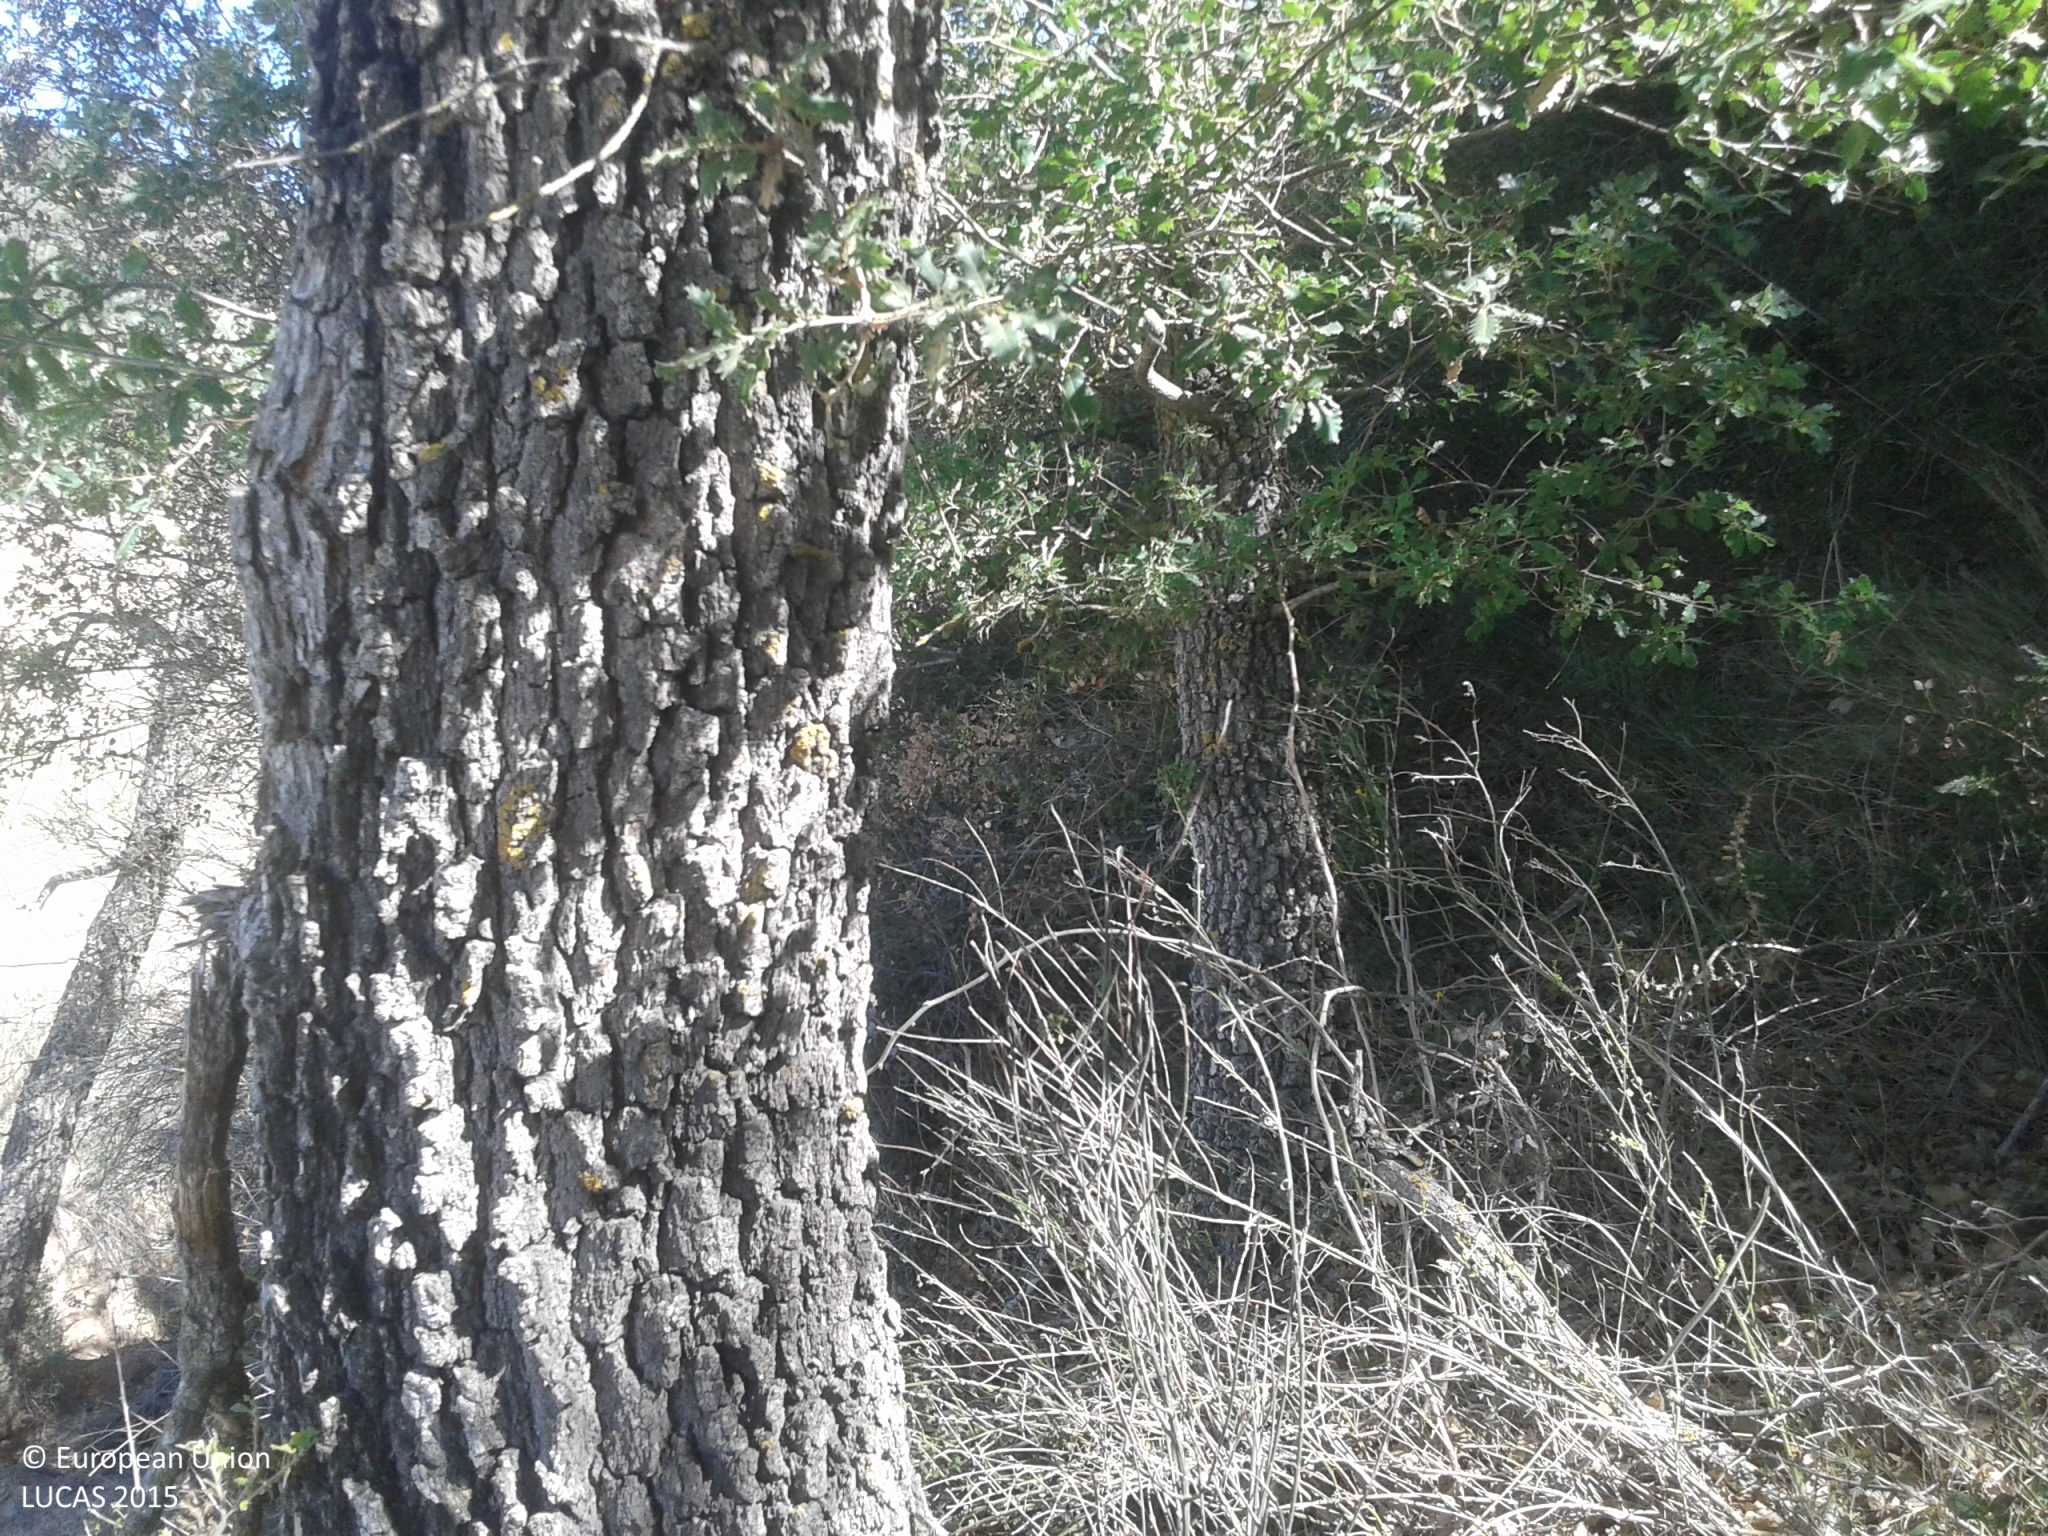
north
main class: Woodland
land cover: Broadleaved woodland
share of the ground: 50 - 75 %
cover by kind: broadleaved forest trees 70 %, shrubs 25 %, herbaceous plants 5 %
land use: Semi-natural and natural areas not in use
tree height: > 5 m
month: May
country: ES
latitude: 41.9324
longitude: 1.0749
